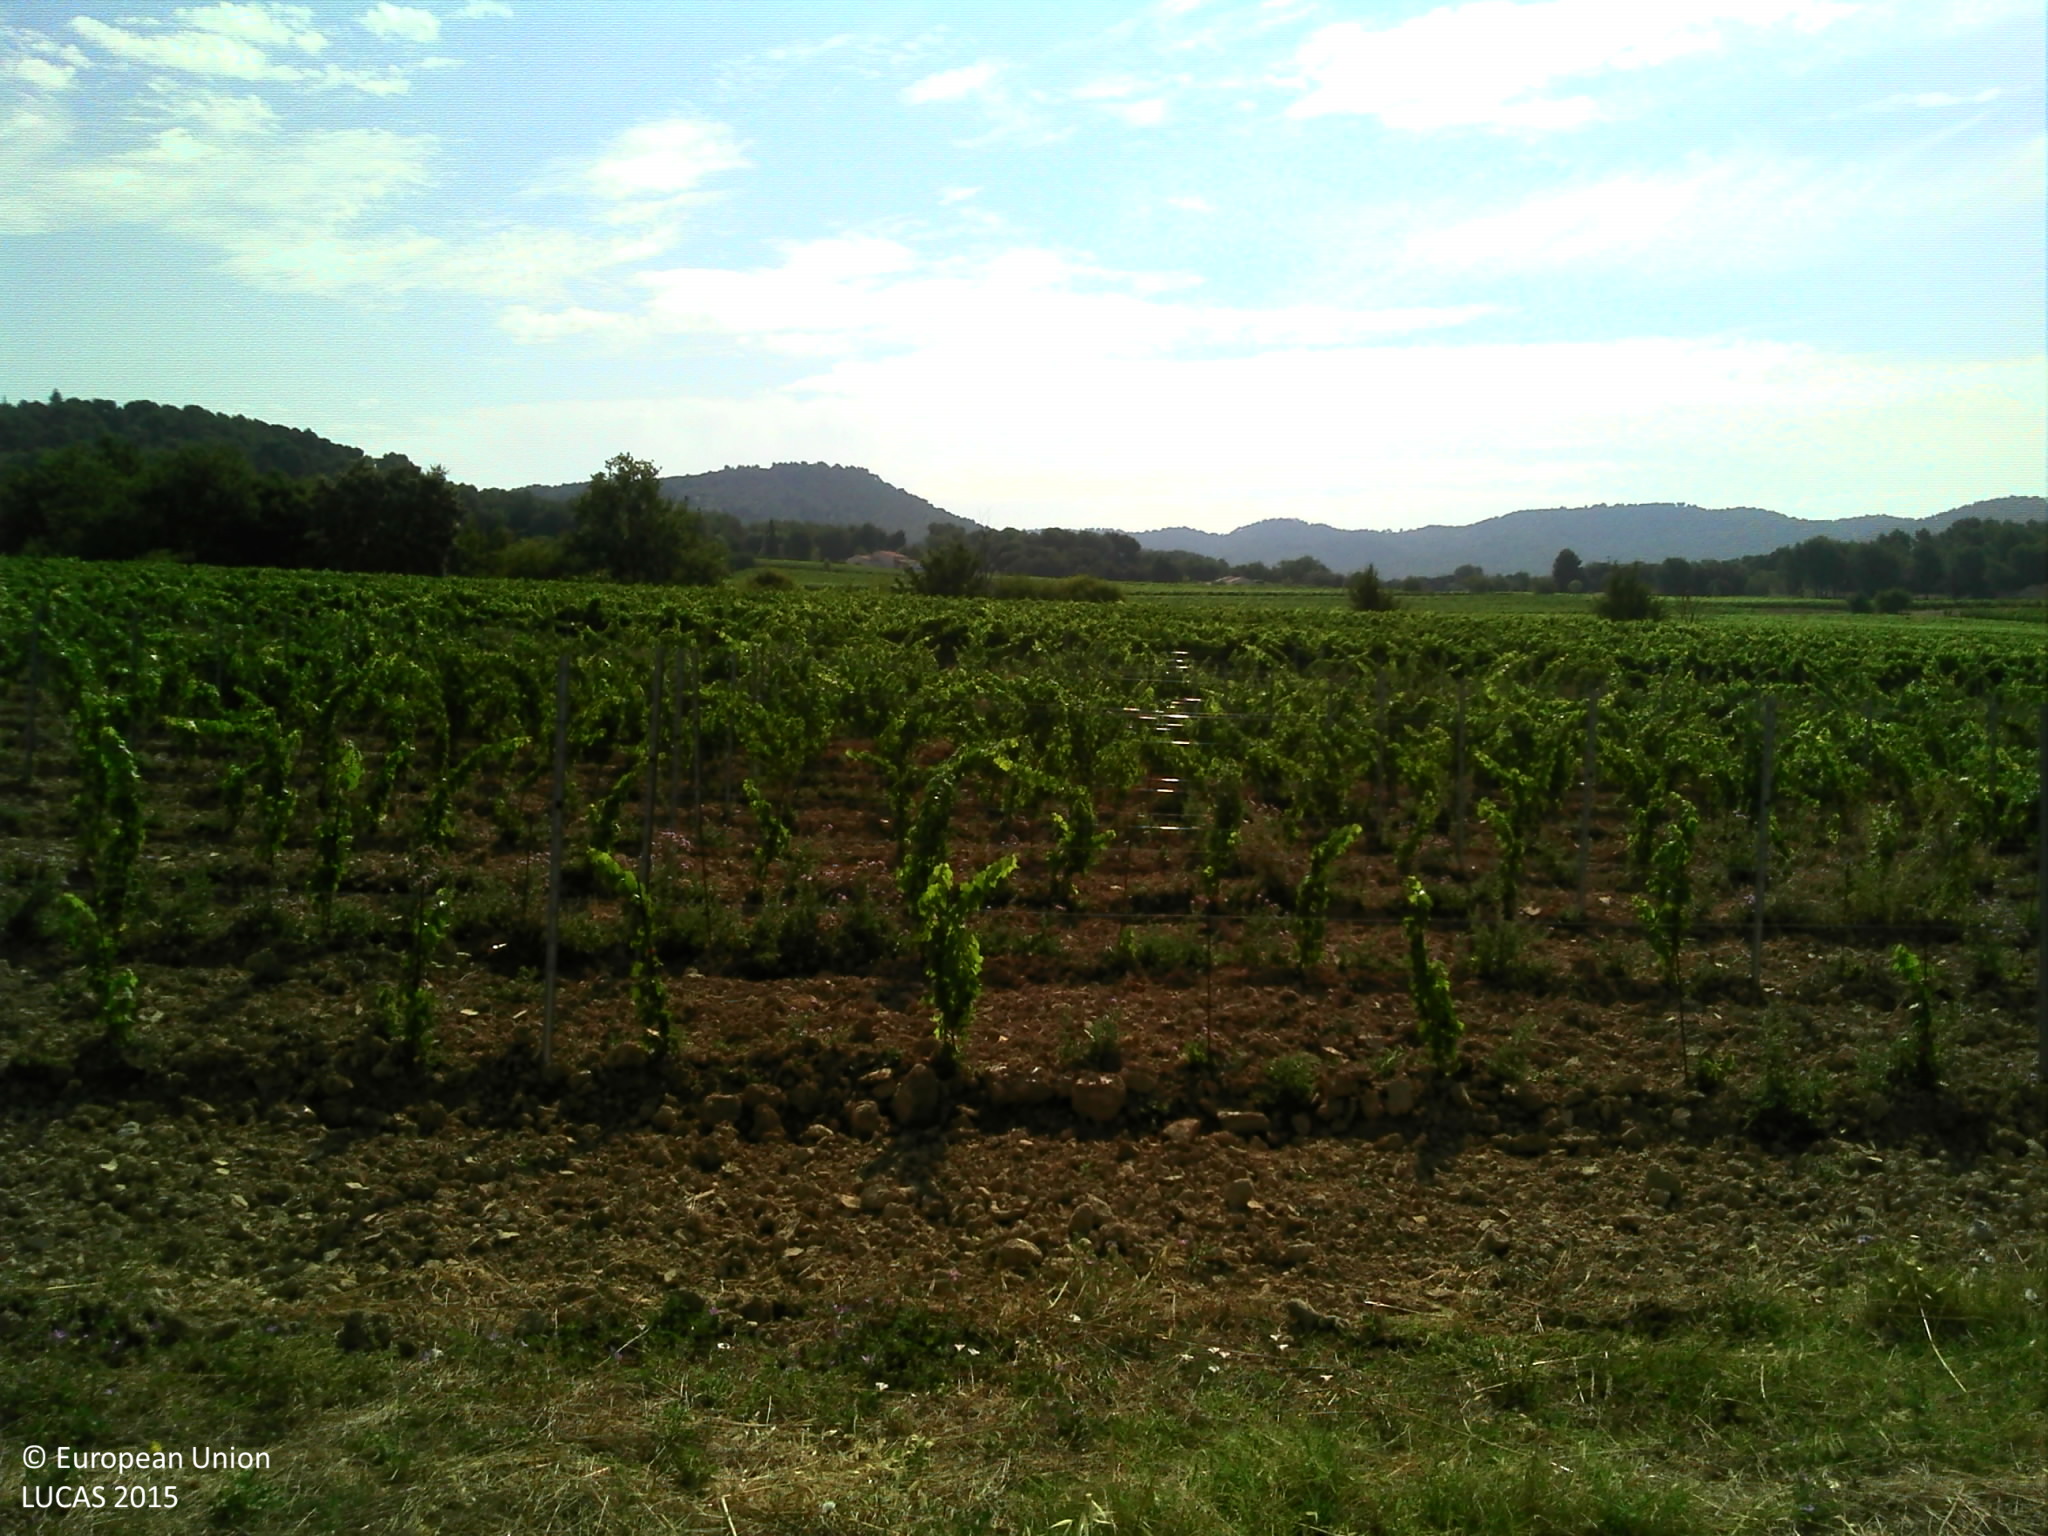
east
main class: Cropland
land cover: Vineyards
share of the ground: 25 - 50 %
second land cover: Other bare soil
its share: > 75 %
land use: Agriculture (excluding fallow land and kitchen gardens)
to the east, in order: Vineyards; Other bare soil; Tracks; Vineyards; Tracks; Grass margins; Shrubland with sparse tree cover; Grass margins; Vineyards; Tracks
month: July
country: FR
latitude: 43.6953
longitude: 5.5548
